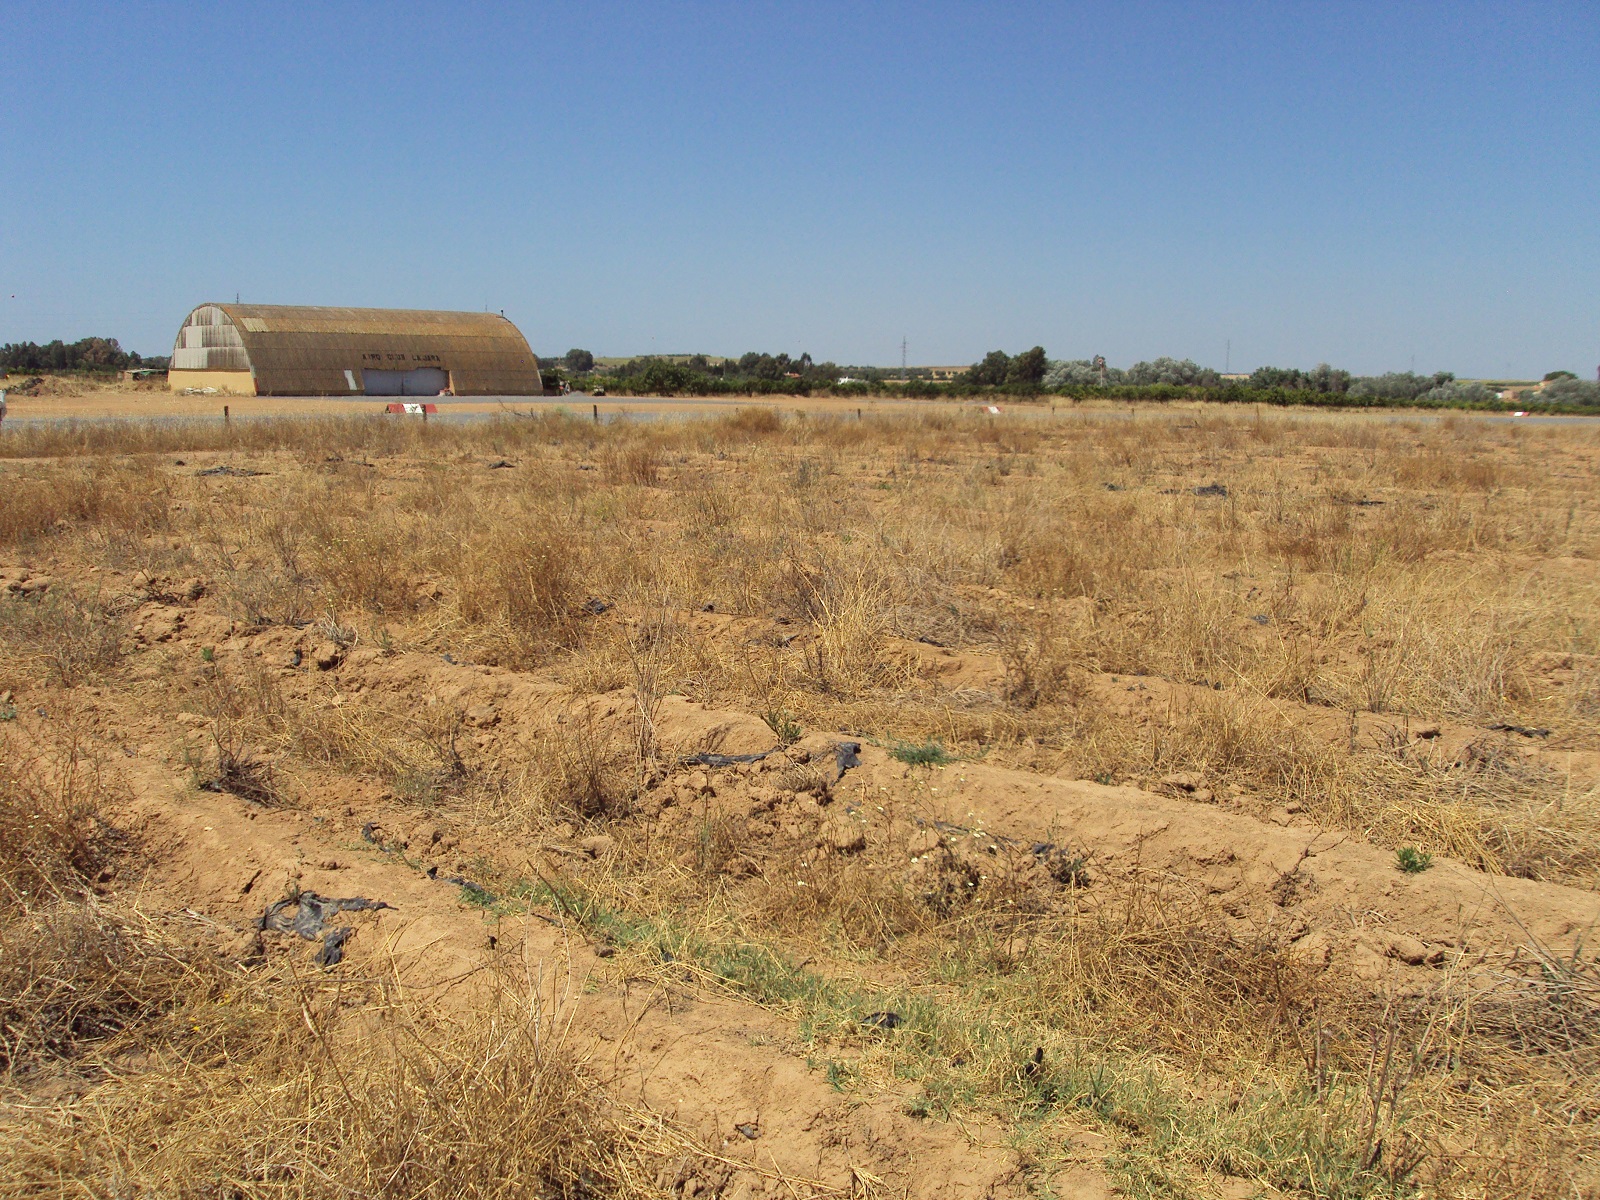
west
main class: Grassland
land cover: Grassland without tree/shrub cover
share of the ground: > 75 %
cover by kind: herbaceous plants 90 %, unconsolidated bare surface 10 %
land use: Agriculture (excluding fallow land and kitchen gardens)
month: June
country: ES
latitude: 37.3647
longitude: -6.9202
